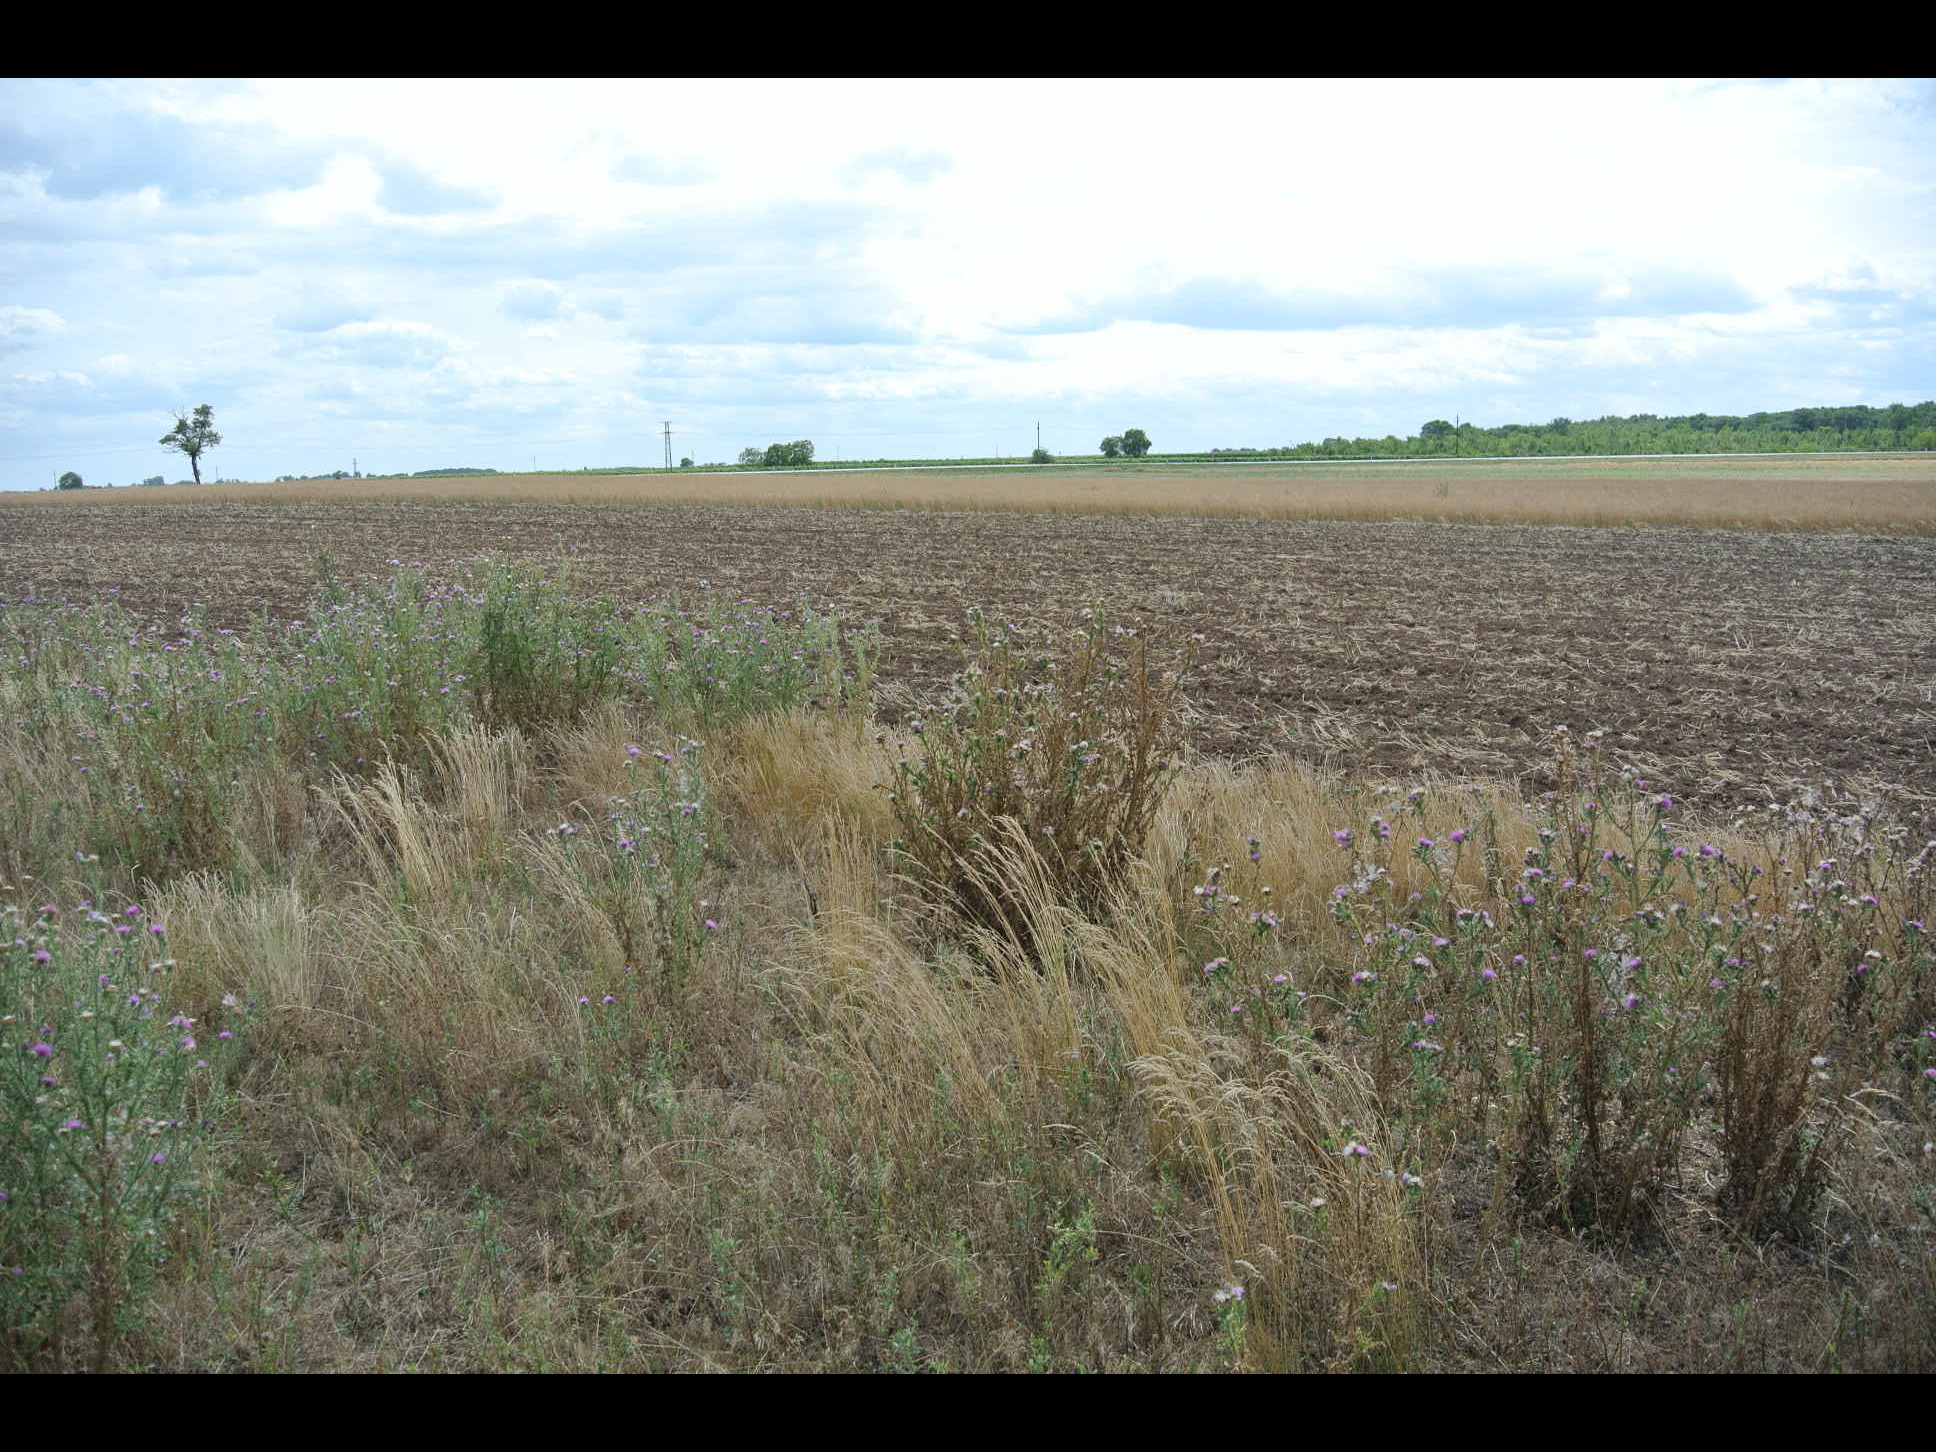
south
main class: Cropland
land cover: Vineyards
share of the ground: 25 - 50 %
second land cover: Spontaneously vegetated surfaces
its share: > 75 %
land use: Agriculture (excluding fallow land and kitchen gardens)
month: July
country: AT
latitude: 47.8455
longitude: 16.8881
